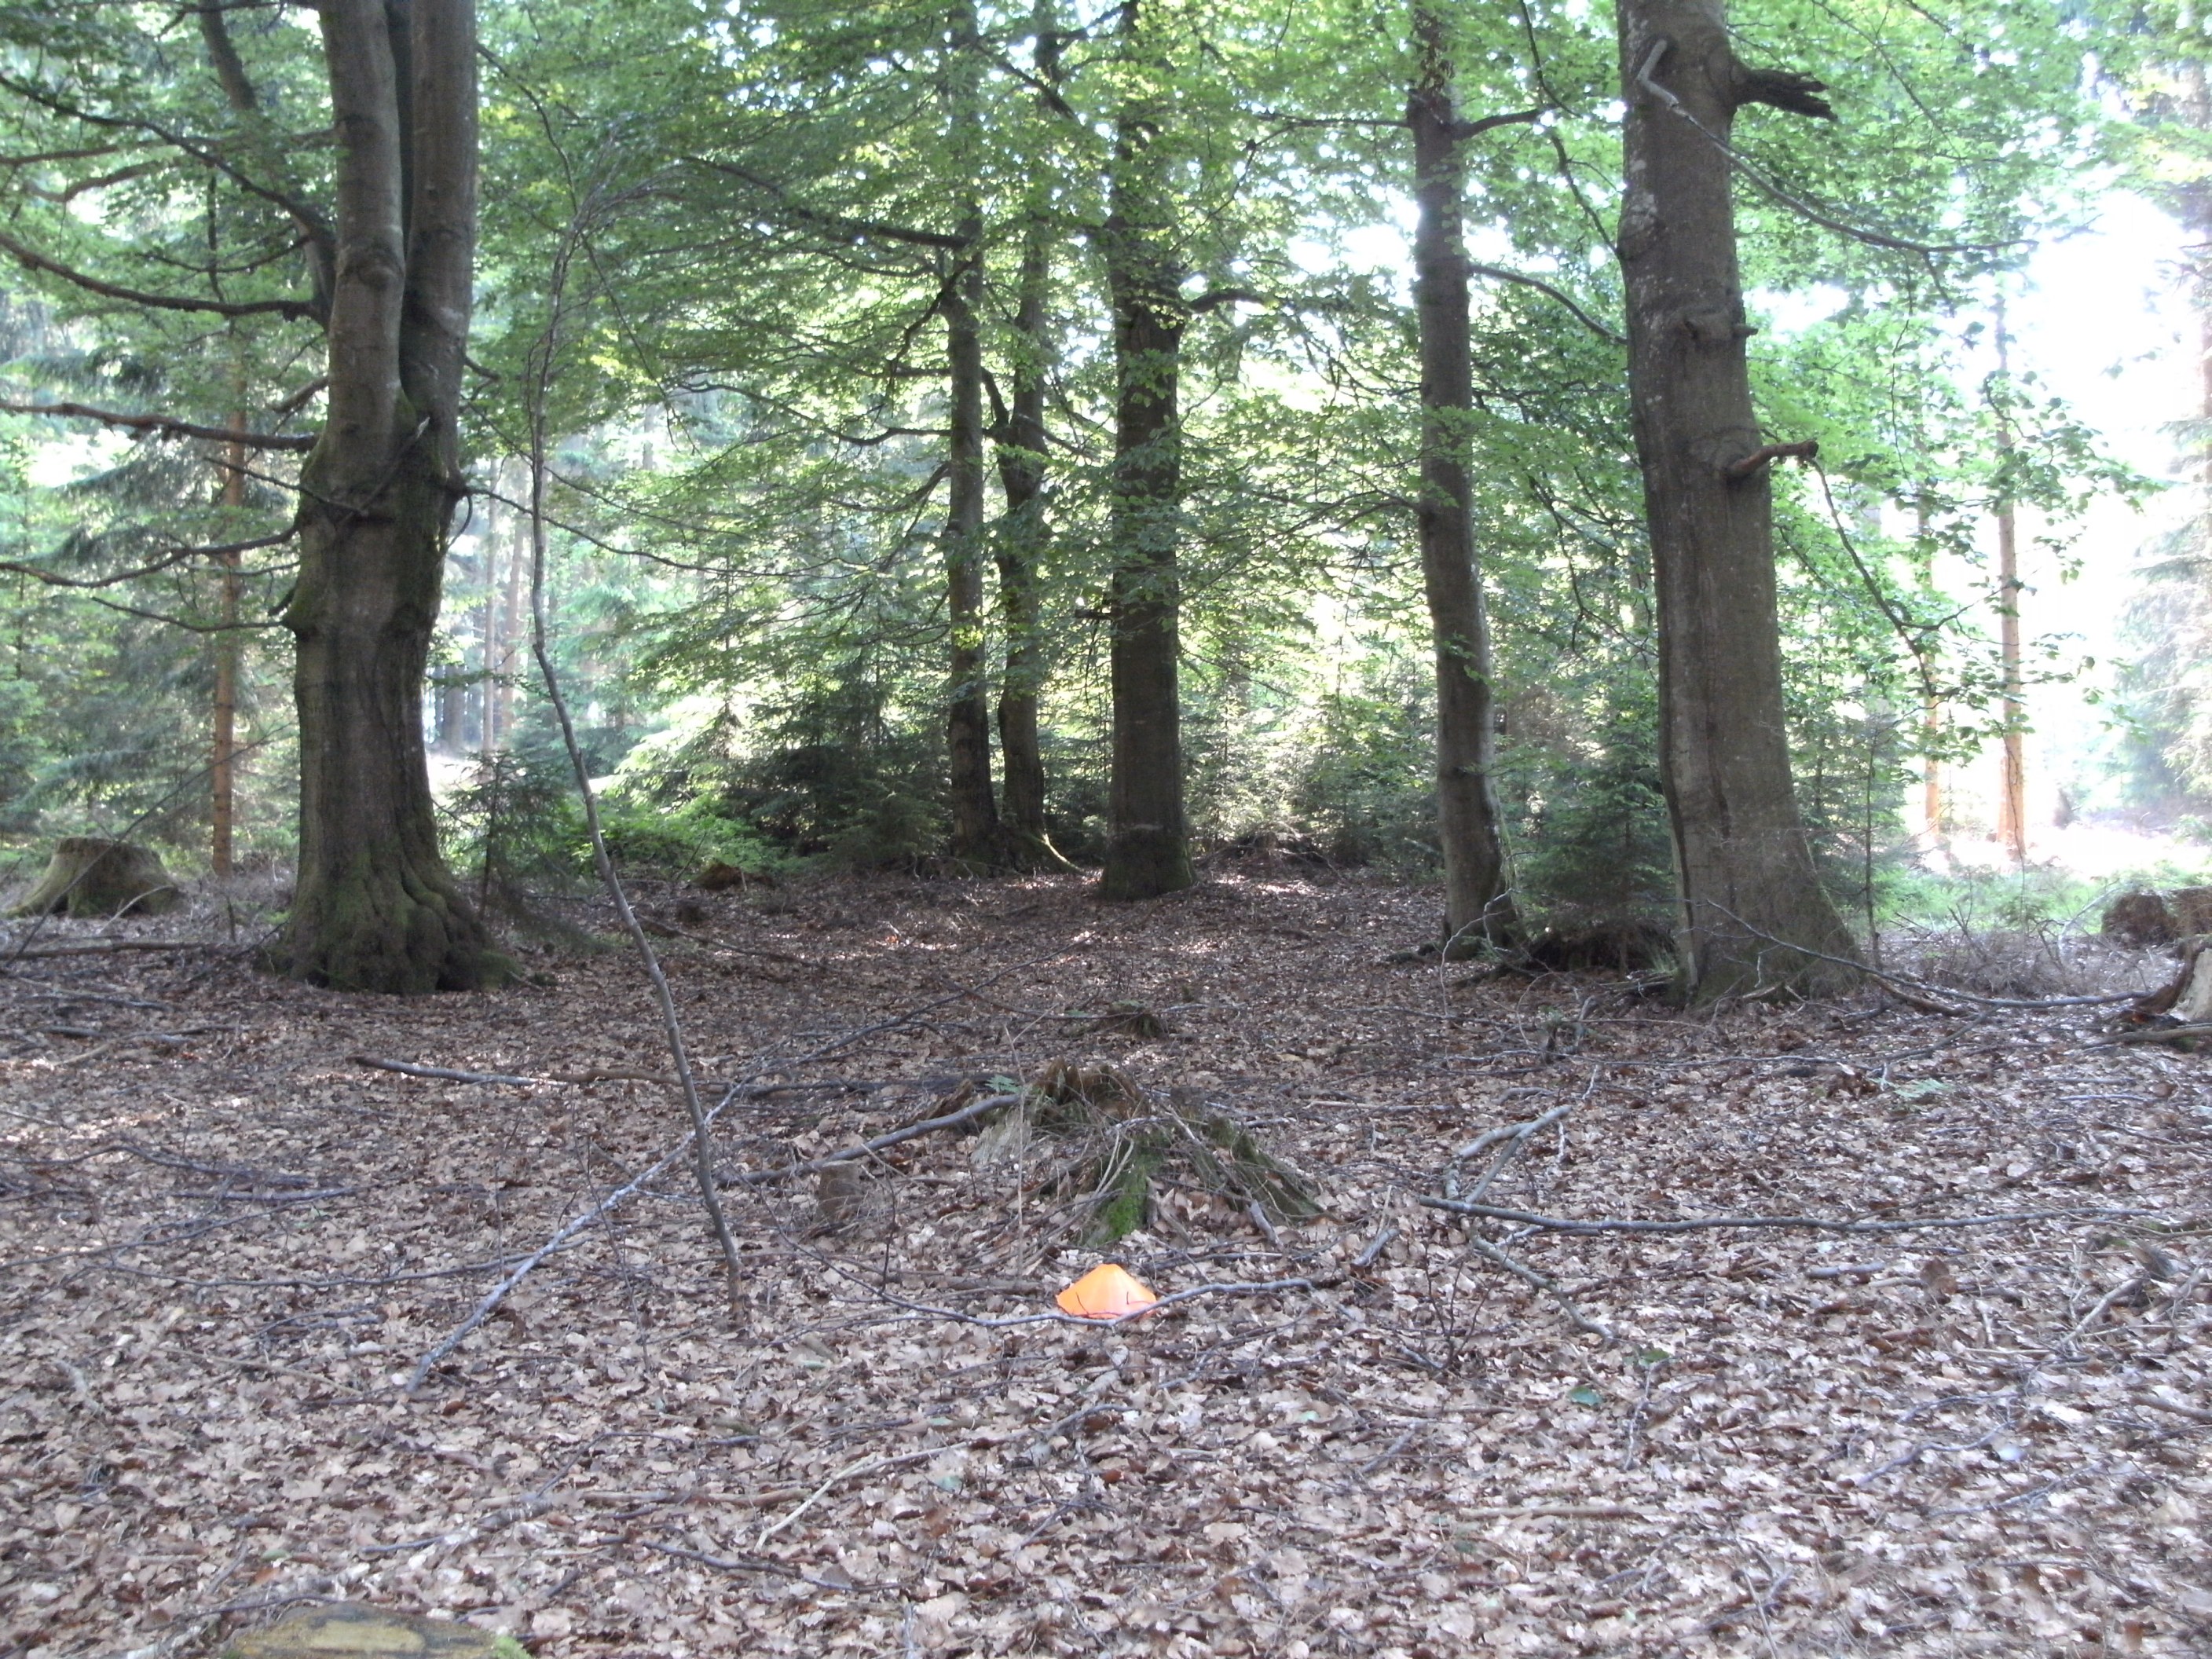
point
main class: Woodland
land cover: Spruce dominated mixed woodland
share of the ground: > 75 %
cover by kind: broadleaved forest trees 70 %, coniferous forest trees 25 %, consolidated bare surface 5 %
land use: Forestry
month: June
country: AT
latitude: 48.4856
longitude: 14.2080
